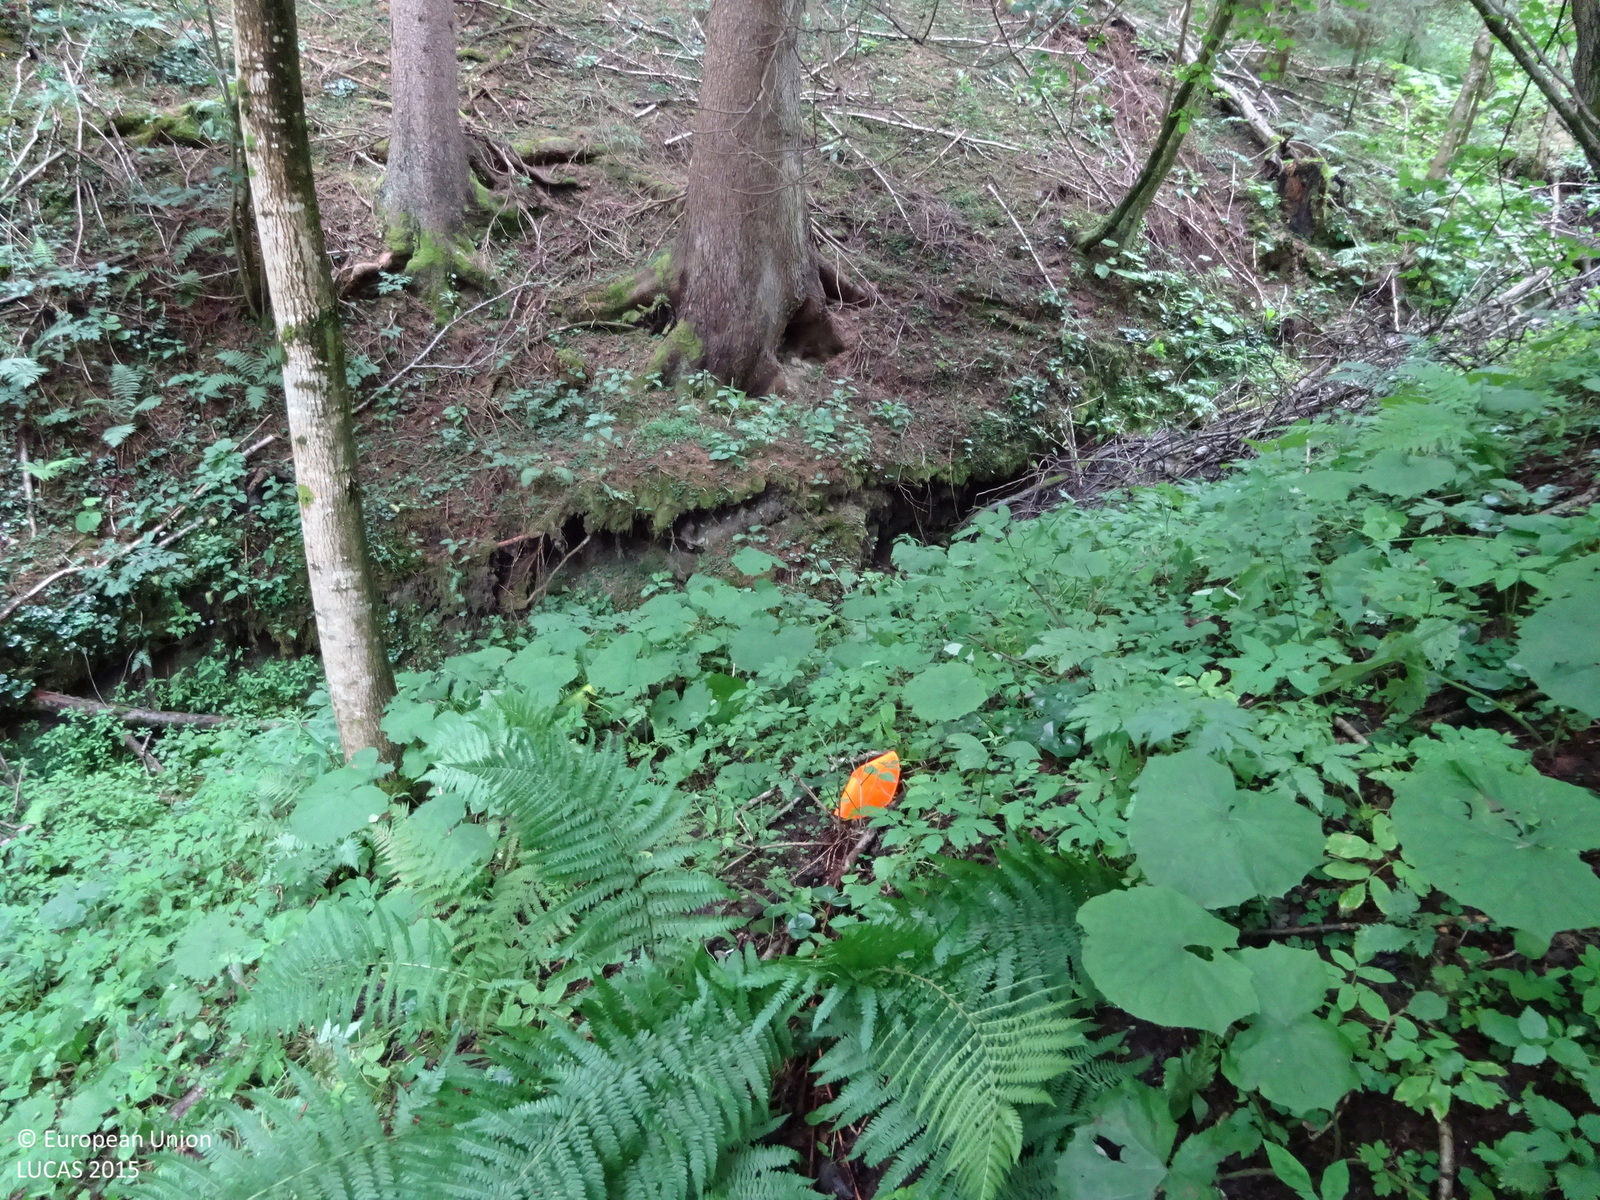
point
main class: Woodland
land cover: Spruce dominated mixed woodland
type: mountainous beech forest
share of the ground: > 75 %
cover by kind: broadleaved forest trees 65 %, coniferous forest trees 25 %, shrubs 10 %
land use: Forestry
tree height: > 5 m
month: July
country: AT
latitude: 47.2380
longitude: 15.5089
